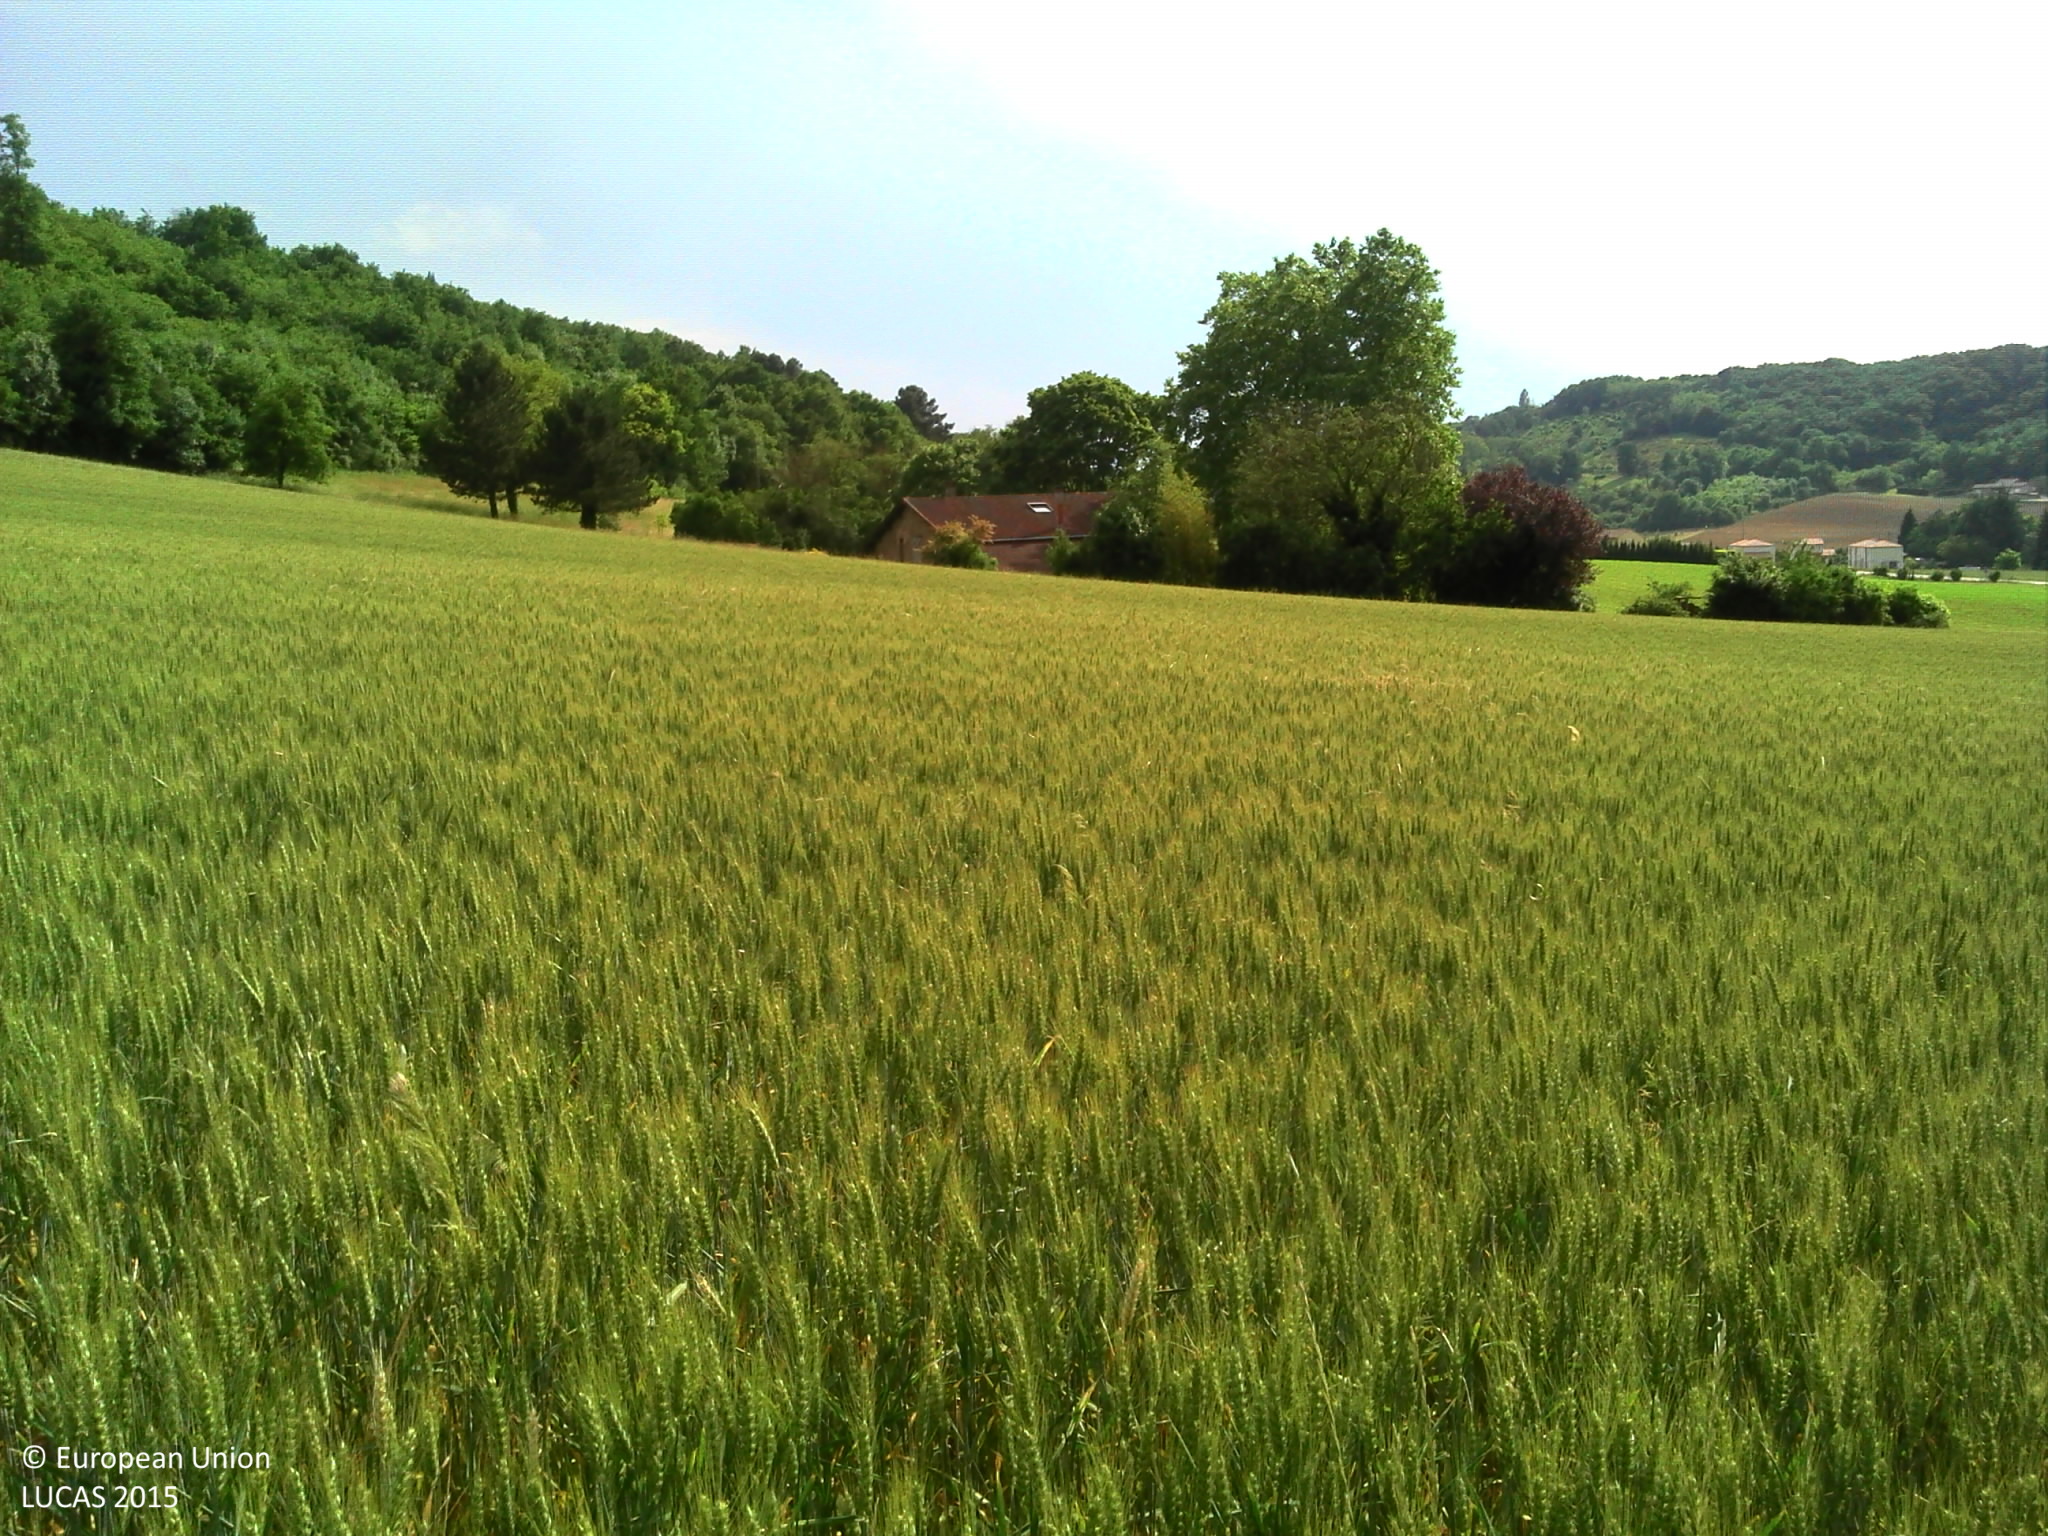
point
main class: Cropland
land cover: Durum wheat
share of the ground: > 75 %
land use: Agriculture (excluding fallow land and kitchen gardens)
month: May
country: FR
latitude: 45.1156
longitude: 5.0097
